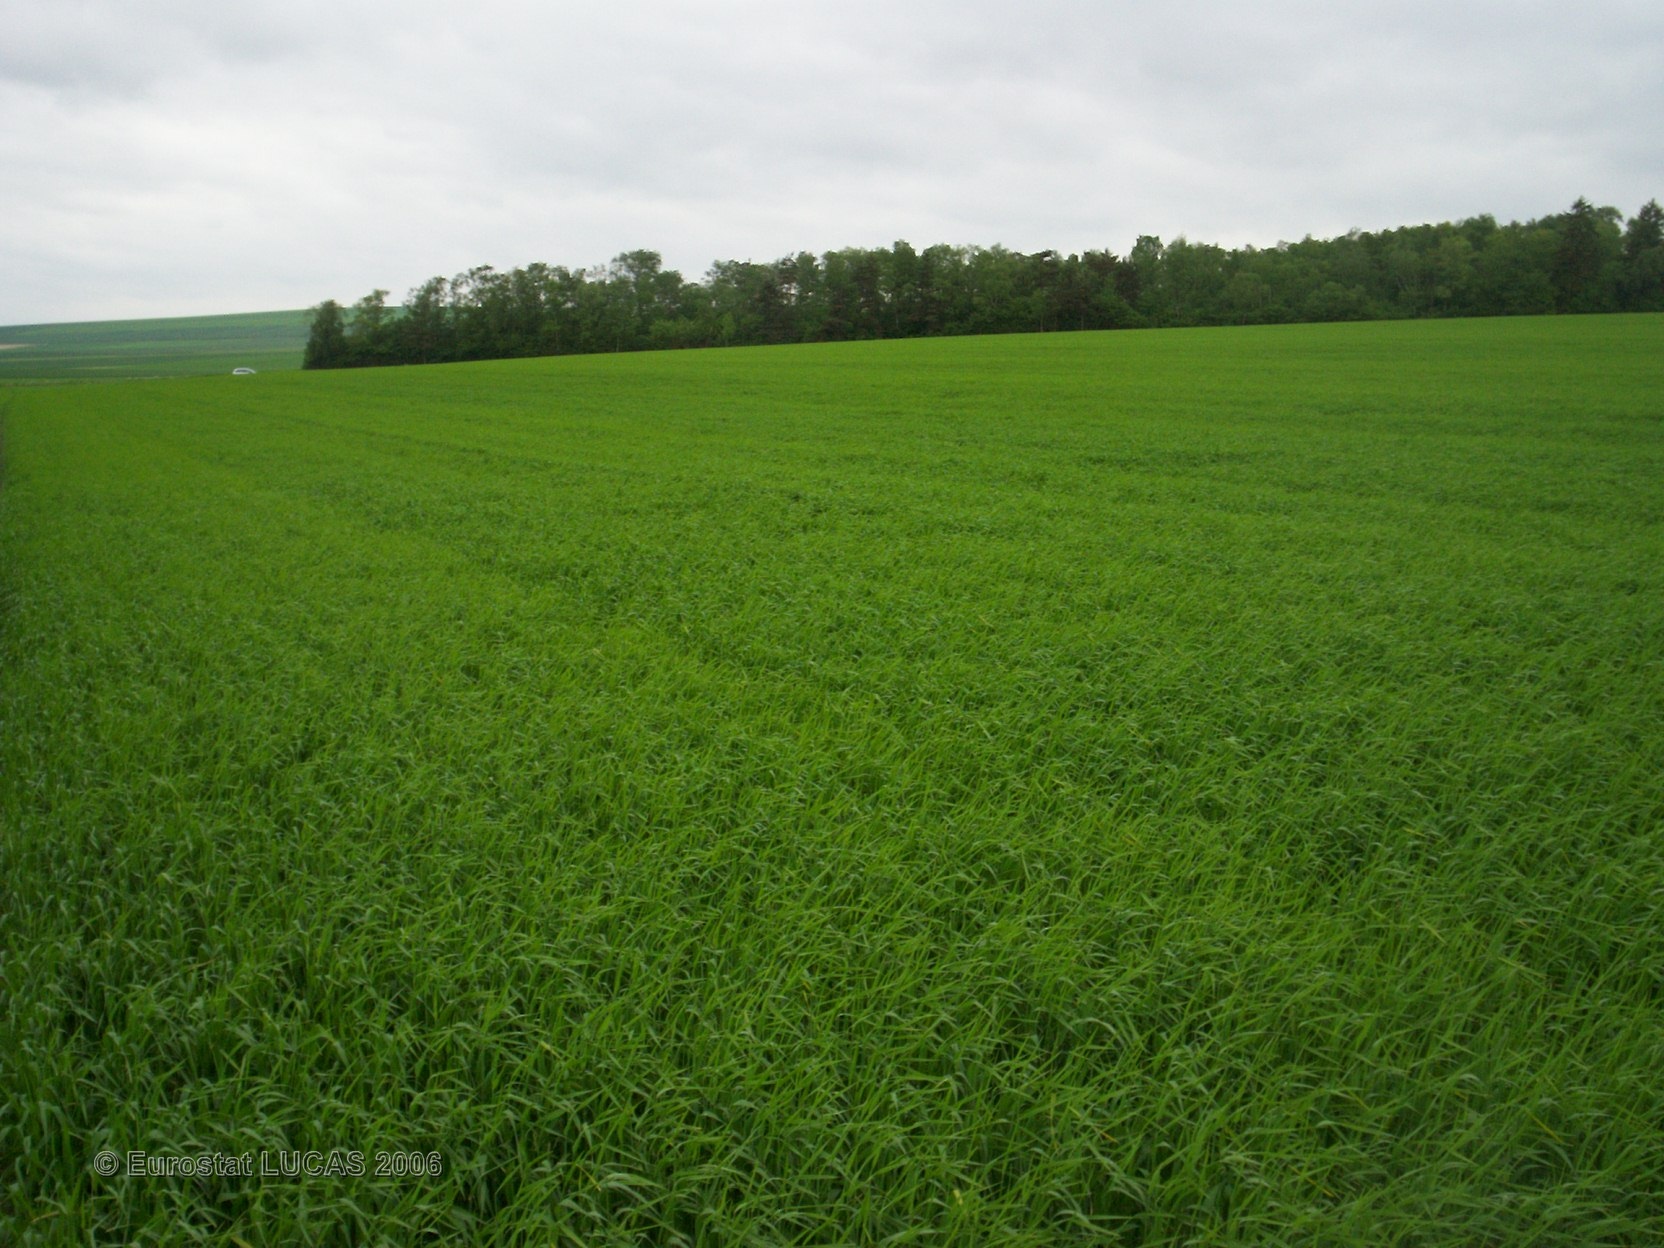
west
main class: Cropland
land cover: Barley
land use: Agriculture (excluding fallow land and kitchen gardens)
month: May
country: FR
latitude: 49.3240
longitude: 4.3688
